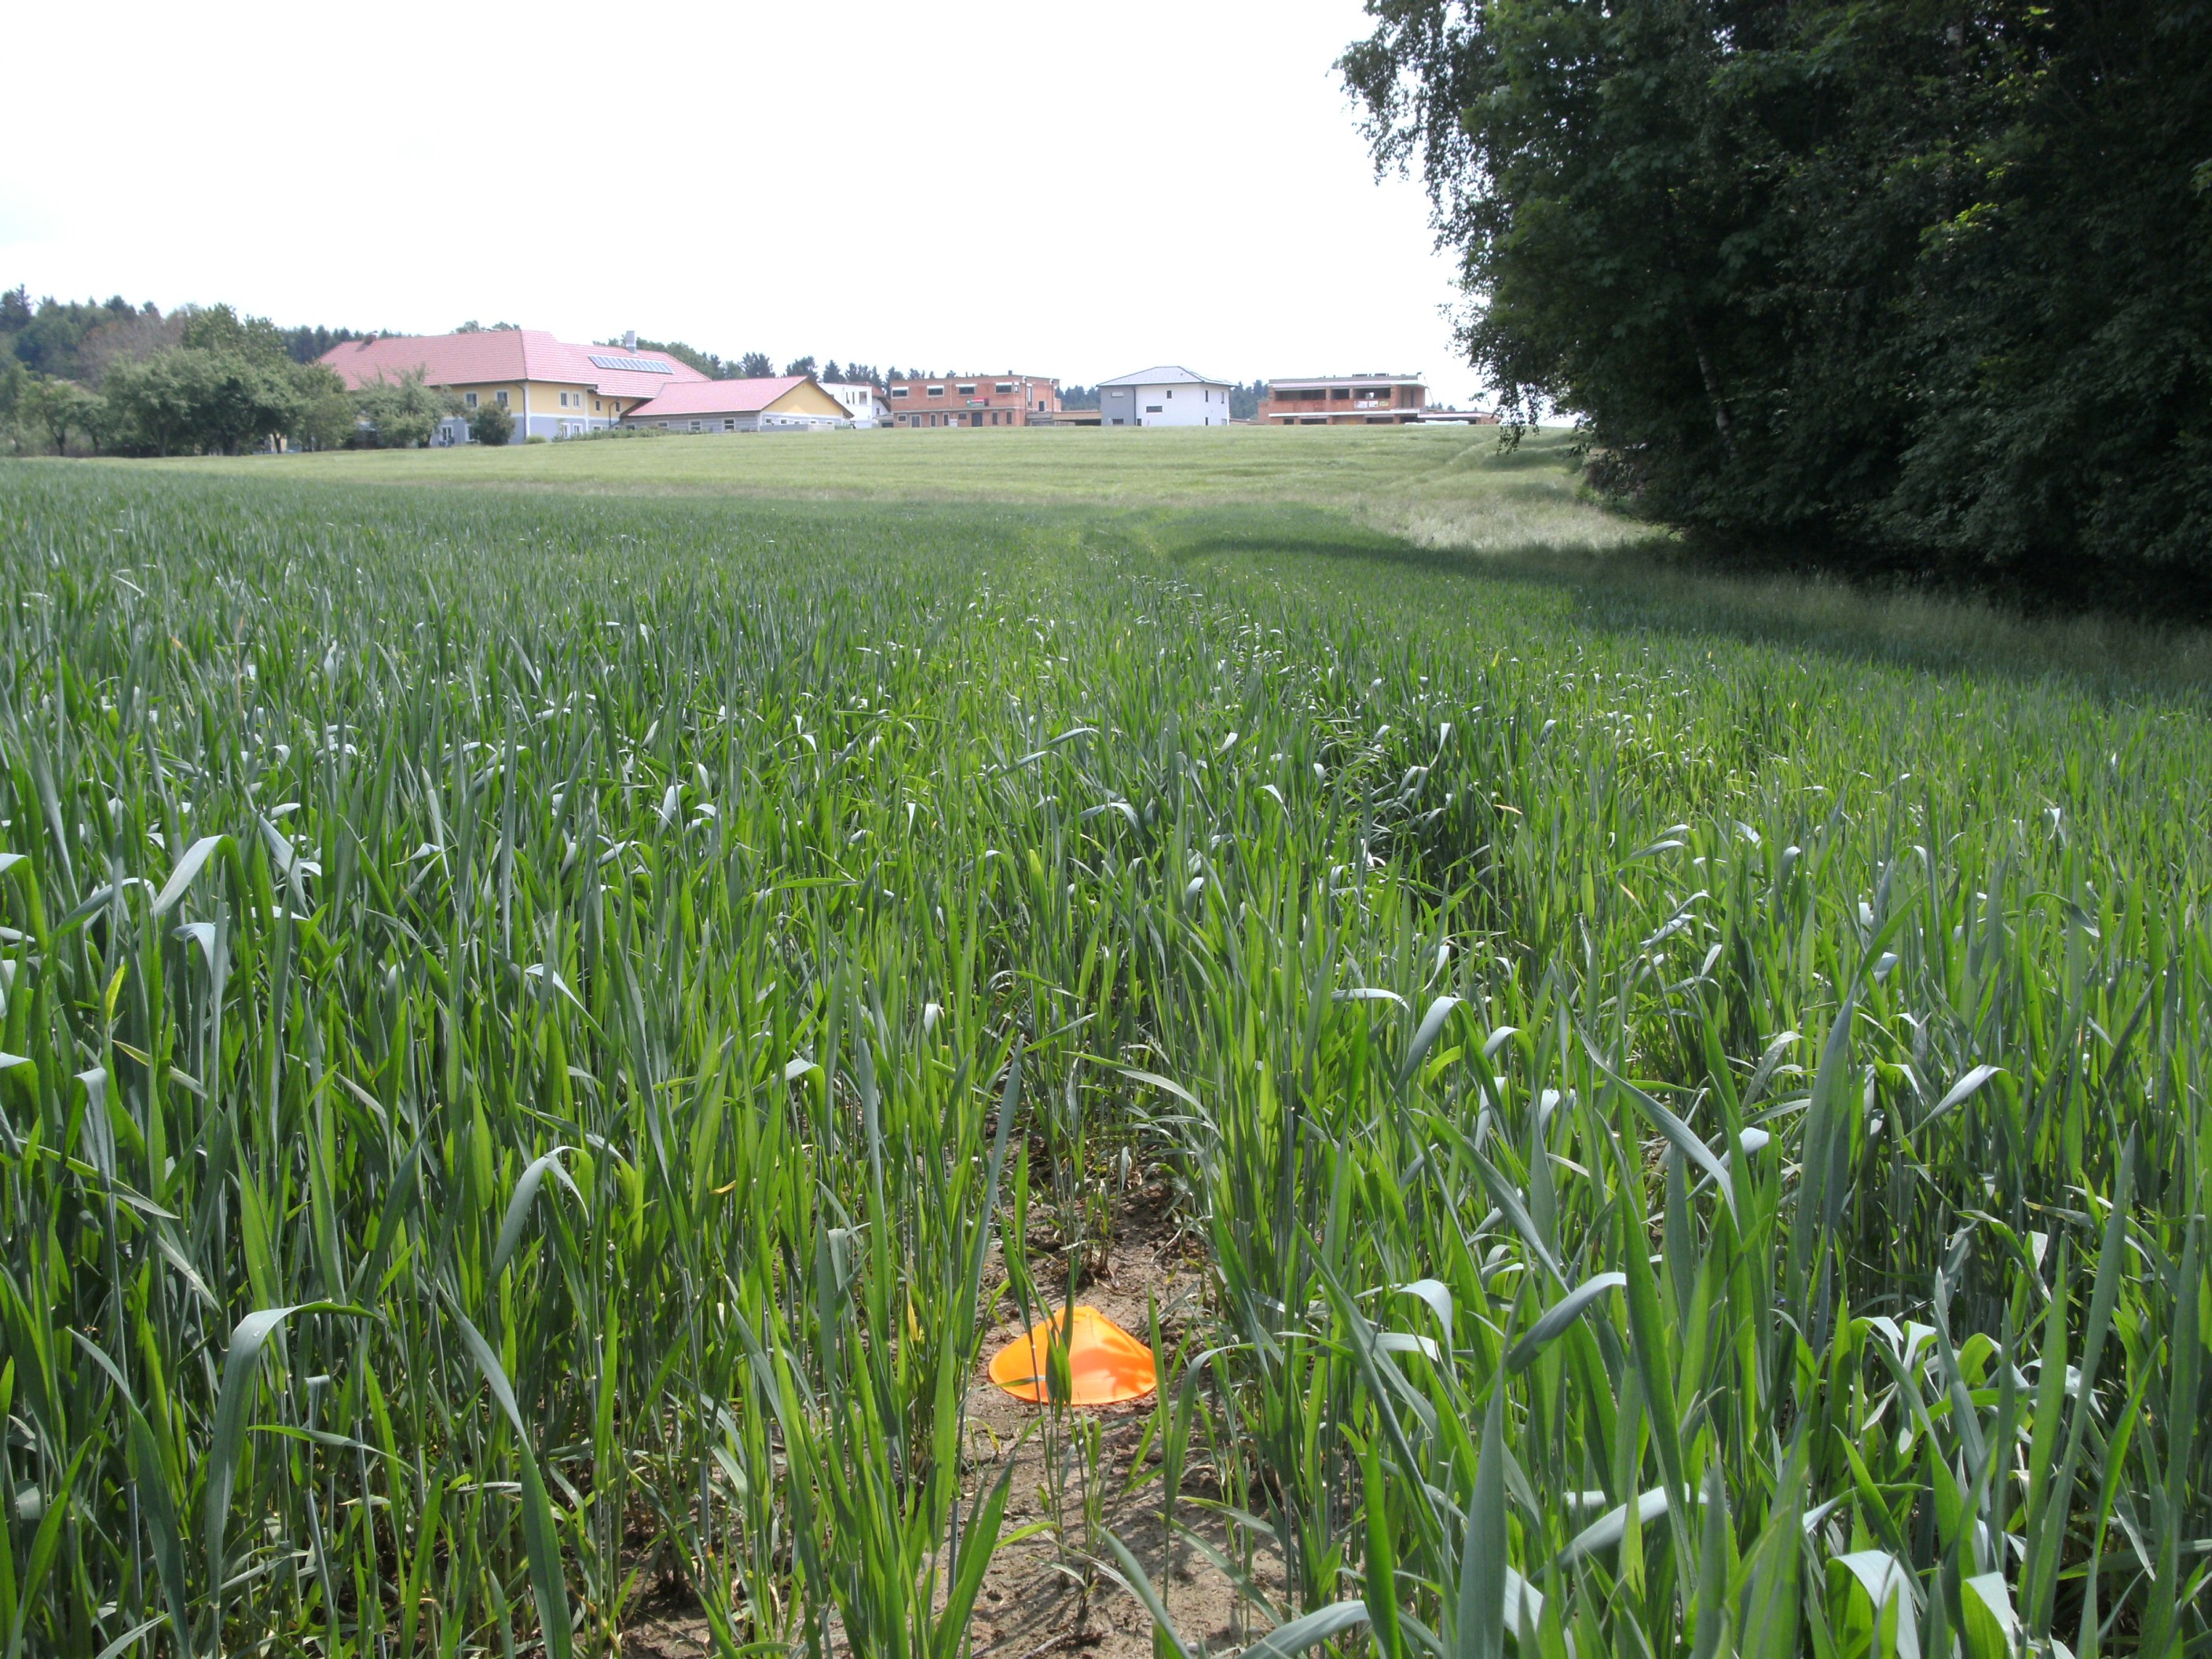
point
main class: Cropland
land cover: Common wheat
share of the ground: > 75 %
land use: Agriculture (excluding fallow land and kitchen gardens)
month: May
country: AT
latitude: 48.0775
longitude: 14.0398
